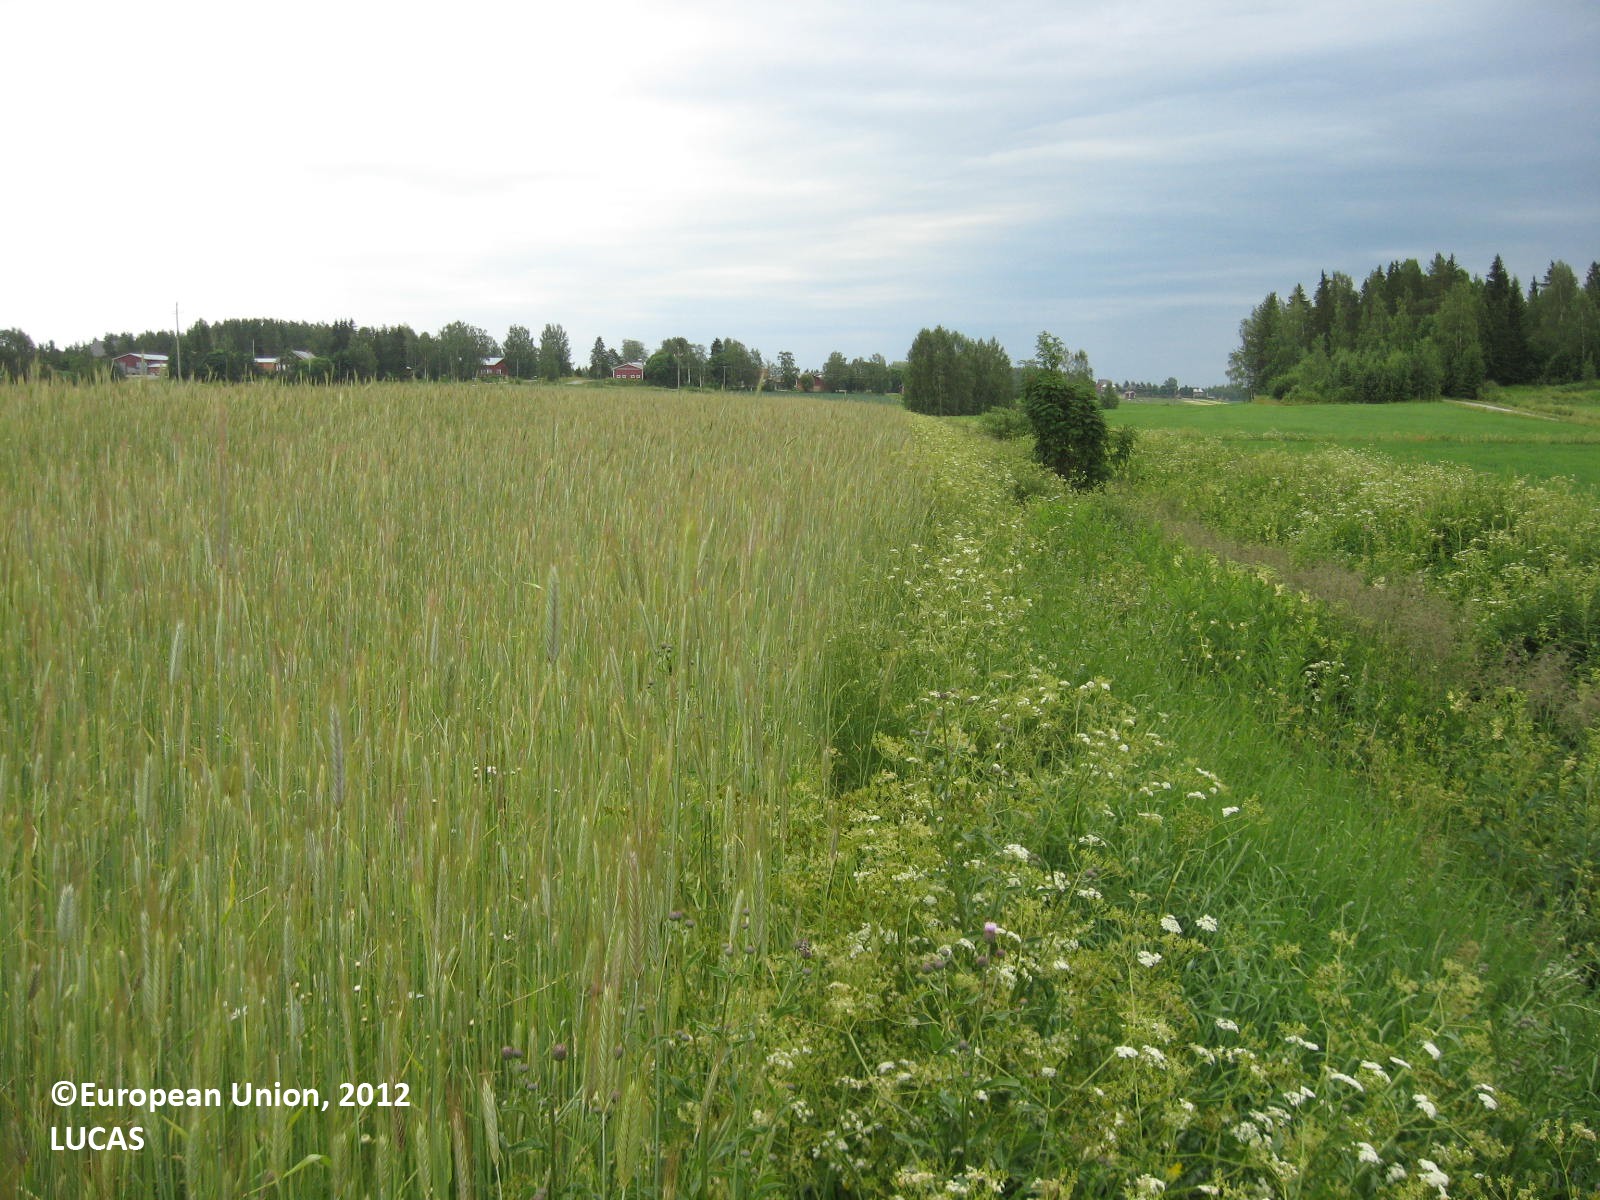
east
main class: Cropland
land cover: Rye
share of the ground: > 75 %
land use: Agriculture (excluding fallow land and kitchen gardens)
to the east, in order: Rye
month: July
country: FI
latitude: 62.4773
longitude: 22.8834
